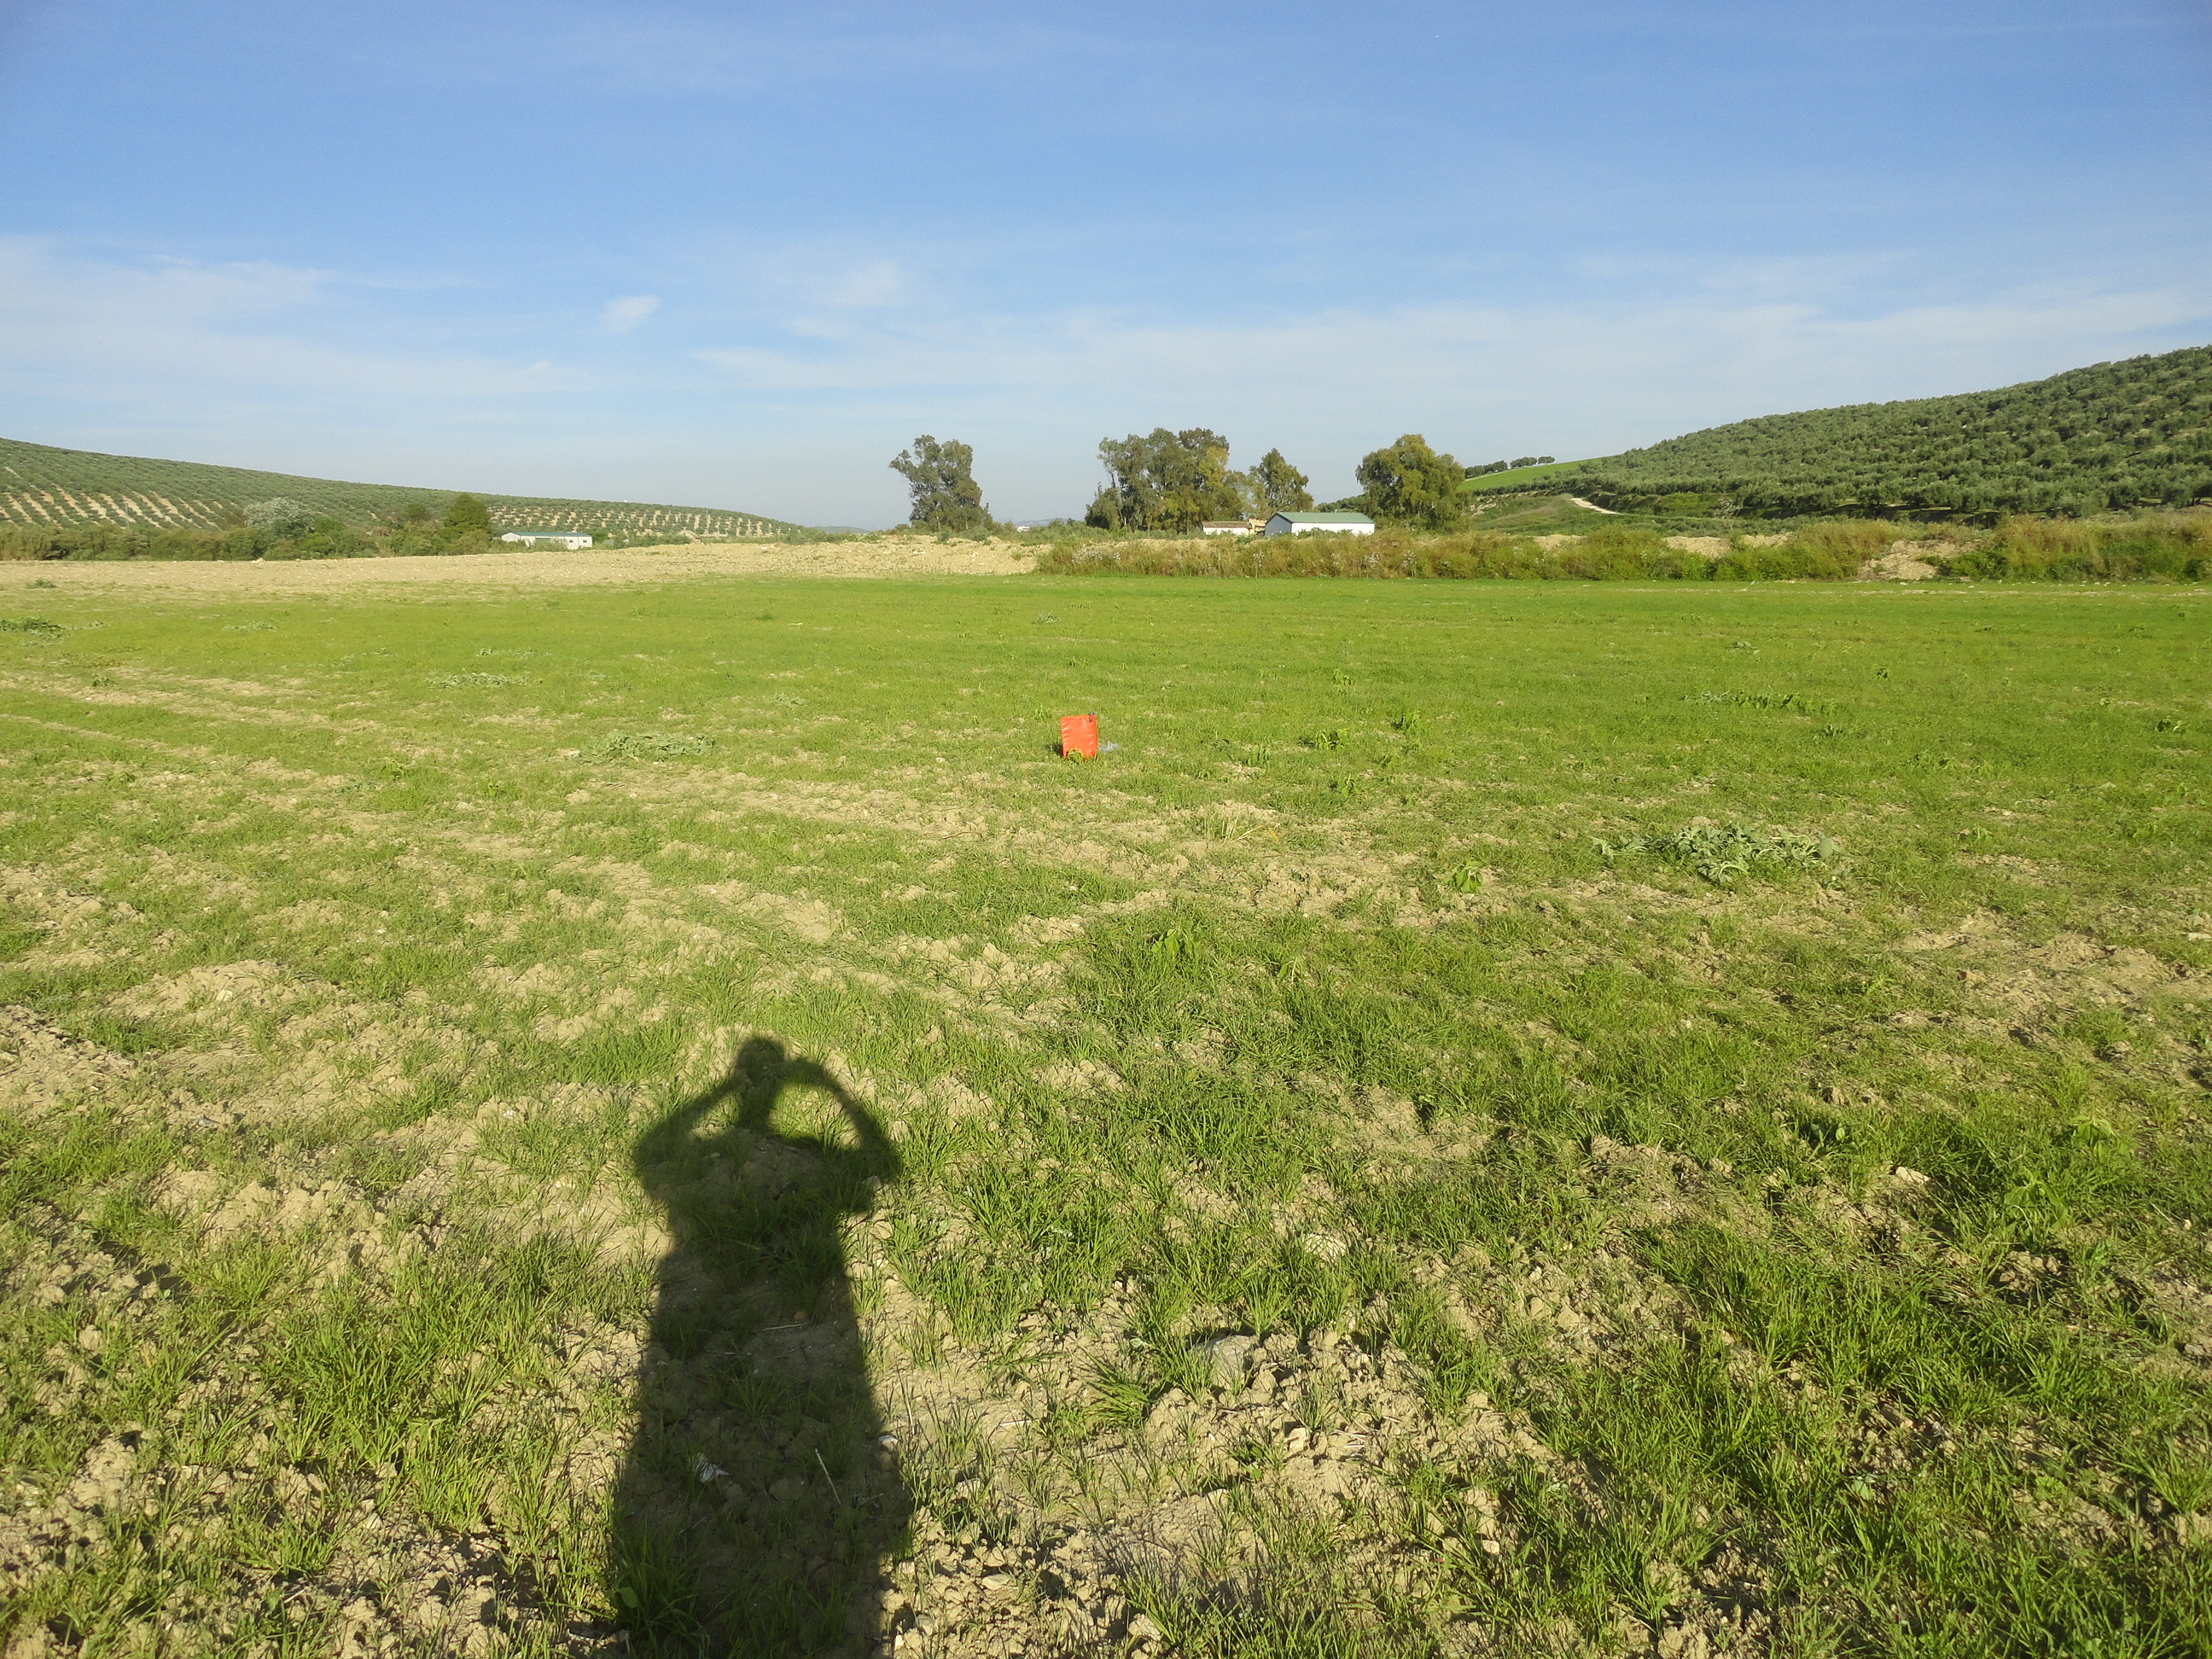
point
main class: Grassland
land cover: Spontaneously vegetated surfaces
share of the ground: 50 - 75 %
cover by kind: herbaceous plants 80 %, unconsolidated bare surface 20 %
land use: Fallow land
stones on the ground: < 10 %
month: April
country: ES
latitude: 37.6942
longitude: -4.5129
